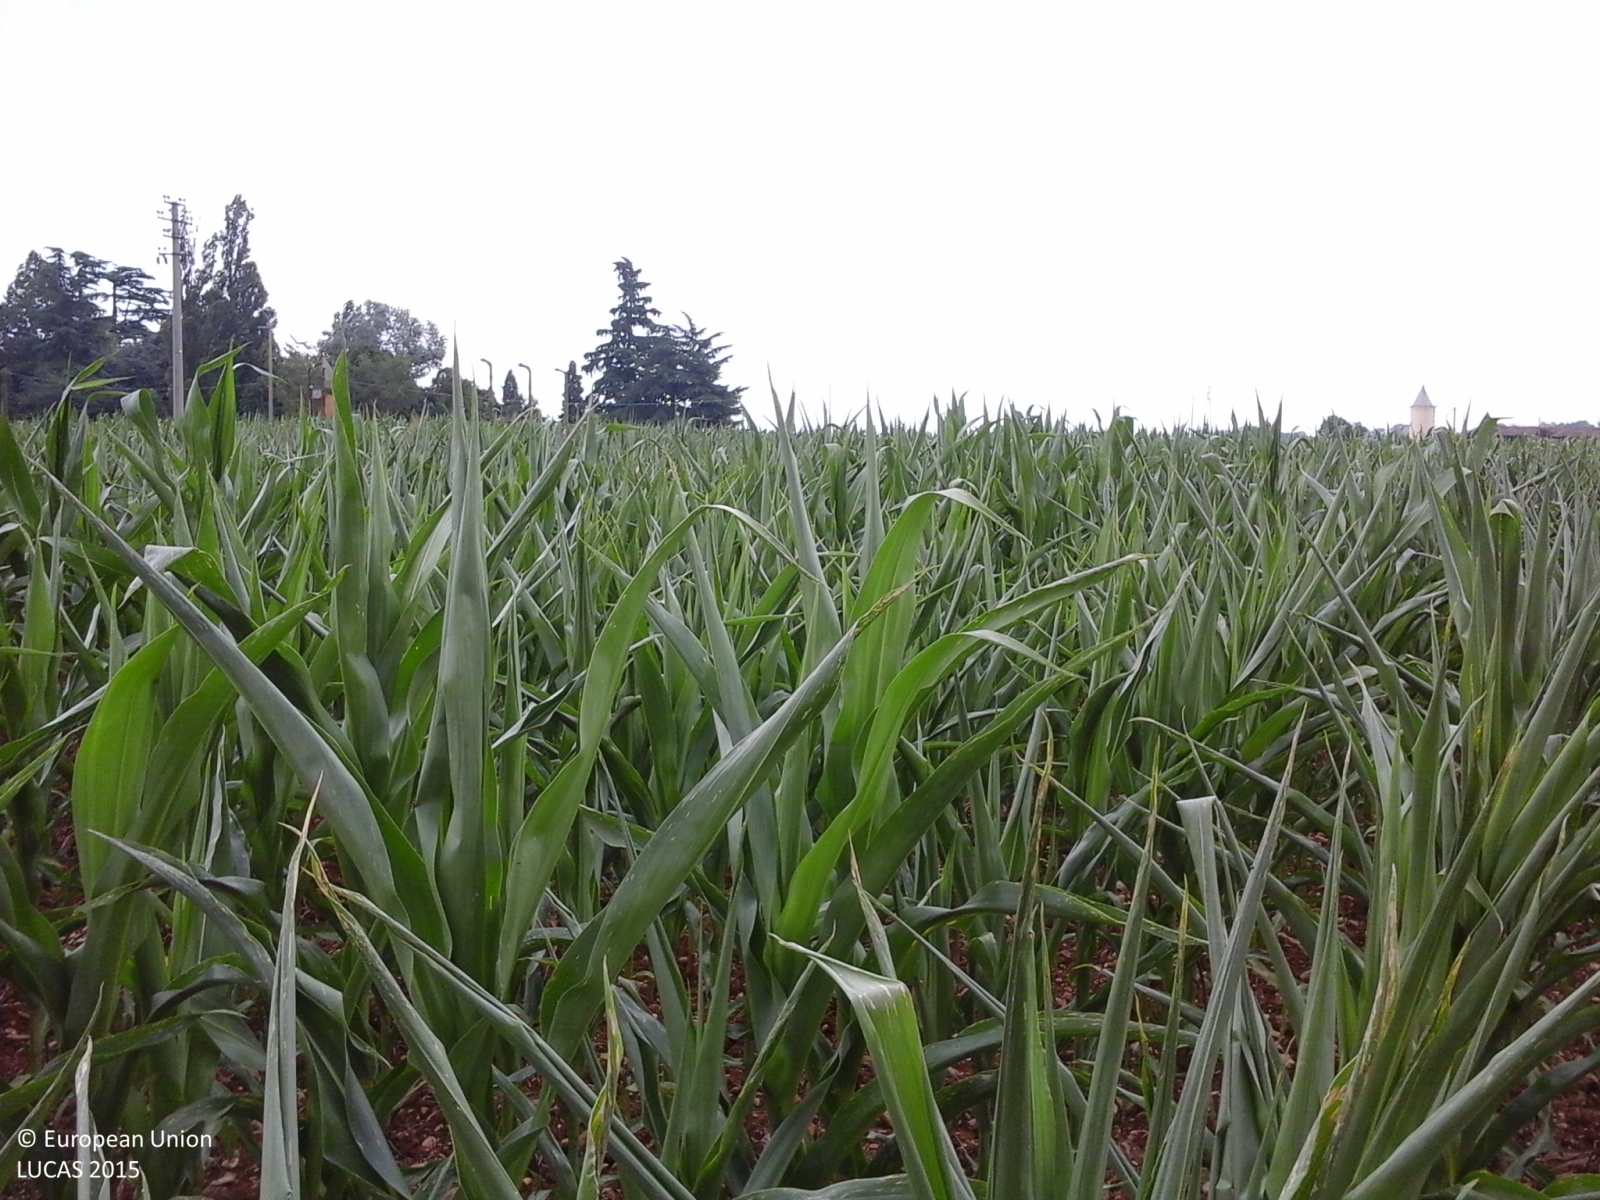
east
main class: Cropland
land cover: Maize
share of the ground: > 75 %
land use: Agriculture (excluding fallow land and kitchen gardens)
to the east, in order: Maize; Other bare soil; Maize; Tracks; Electric lines; Grass margins; Ditches and canals; Durum wheat; Electric lines; Durum wheat; Artificial constructions in urban areas; Durum wheat
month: June
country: IT
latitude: 44.8734
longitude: 9.8863
